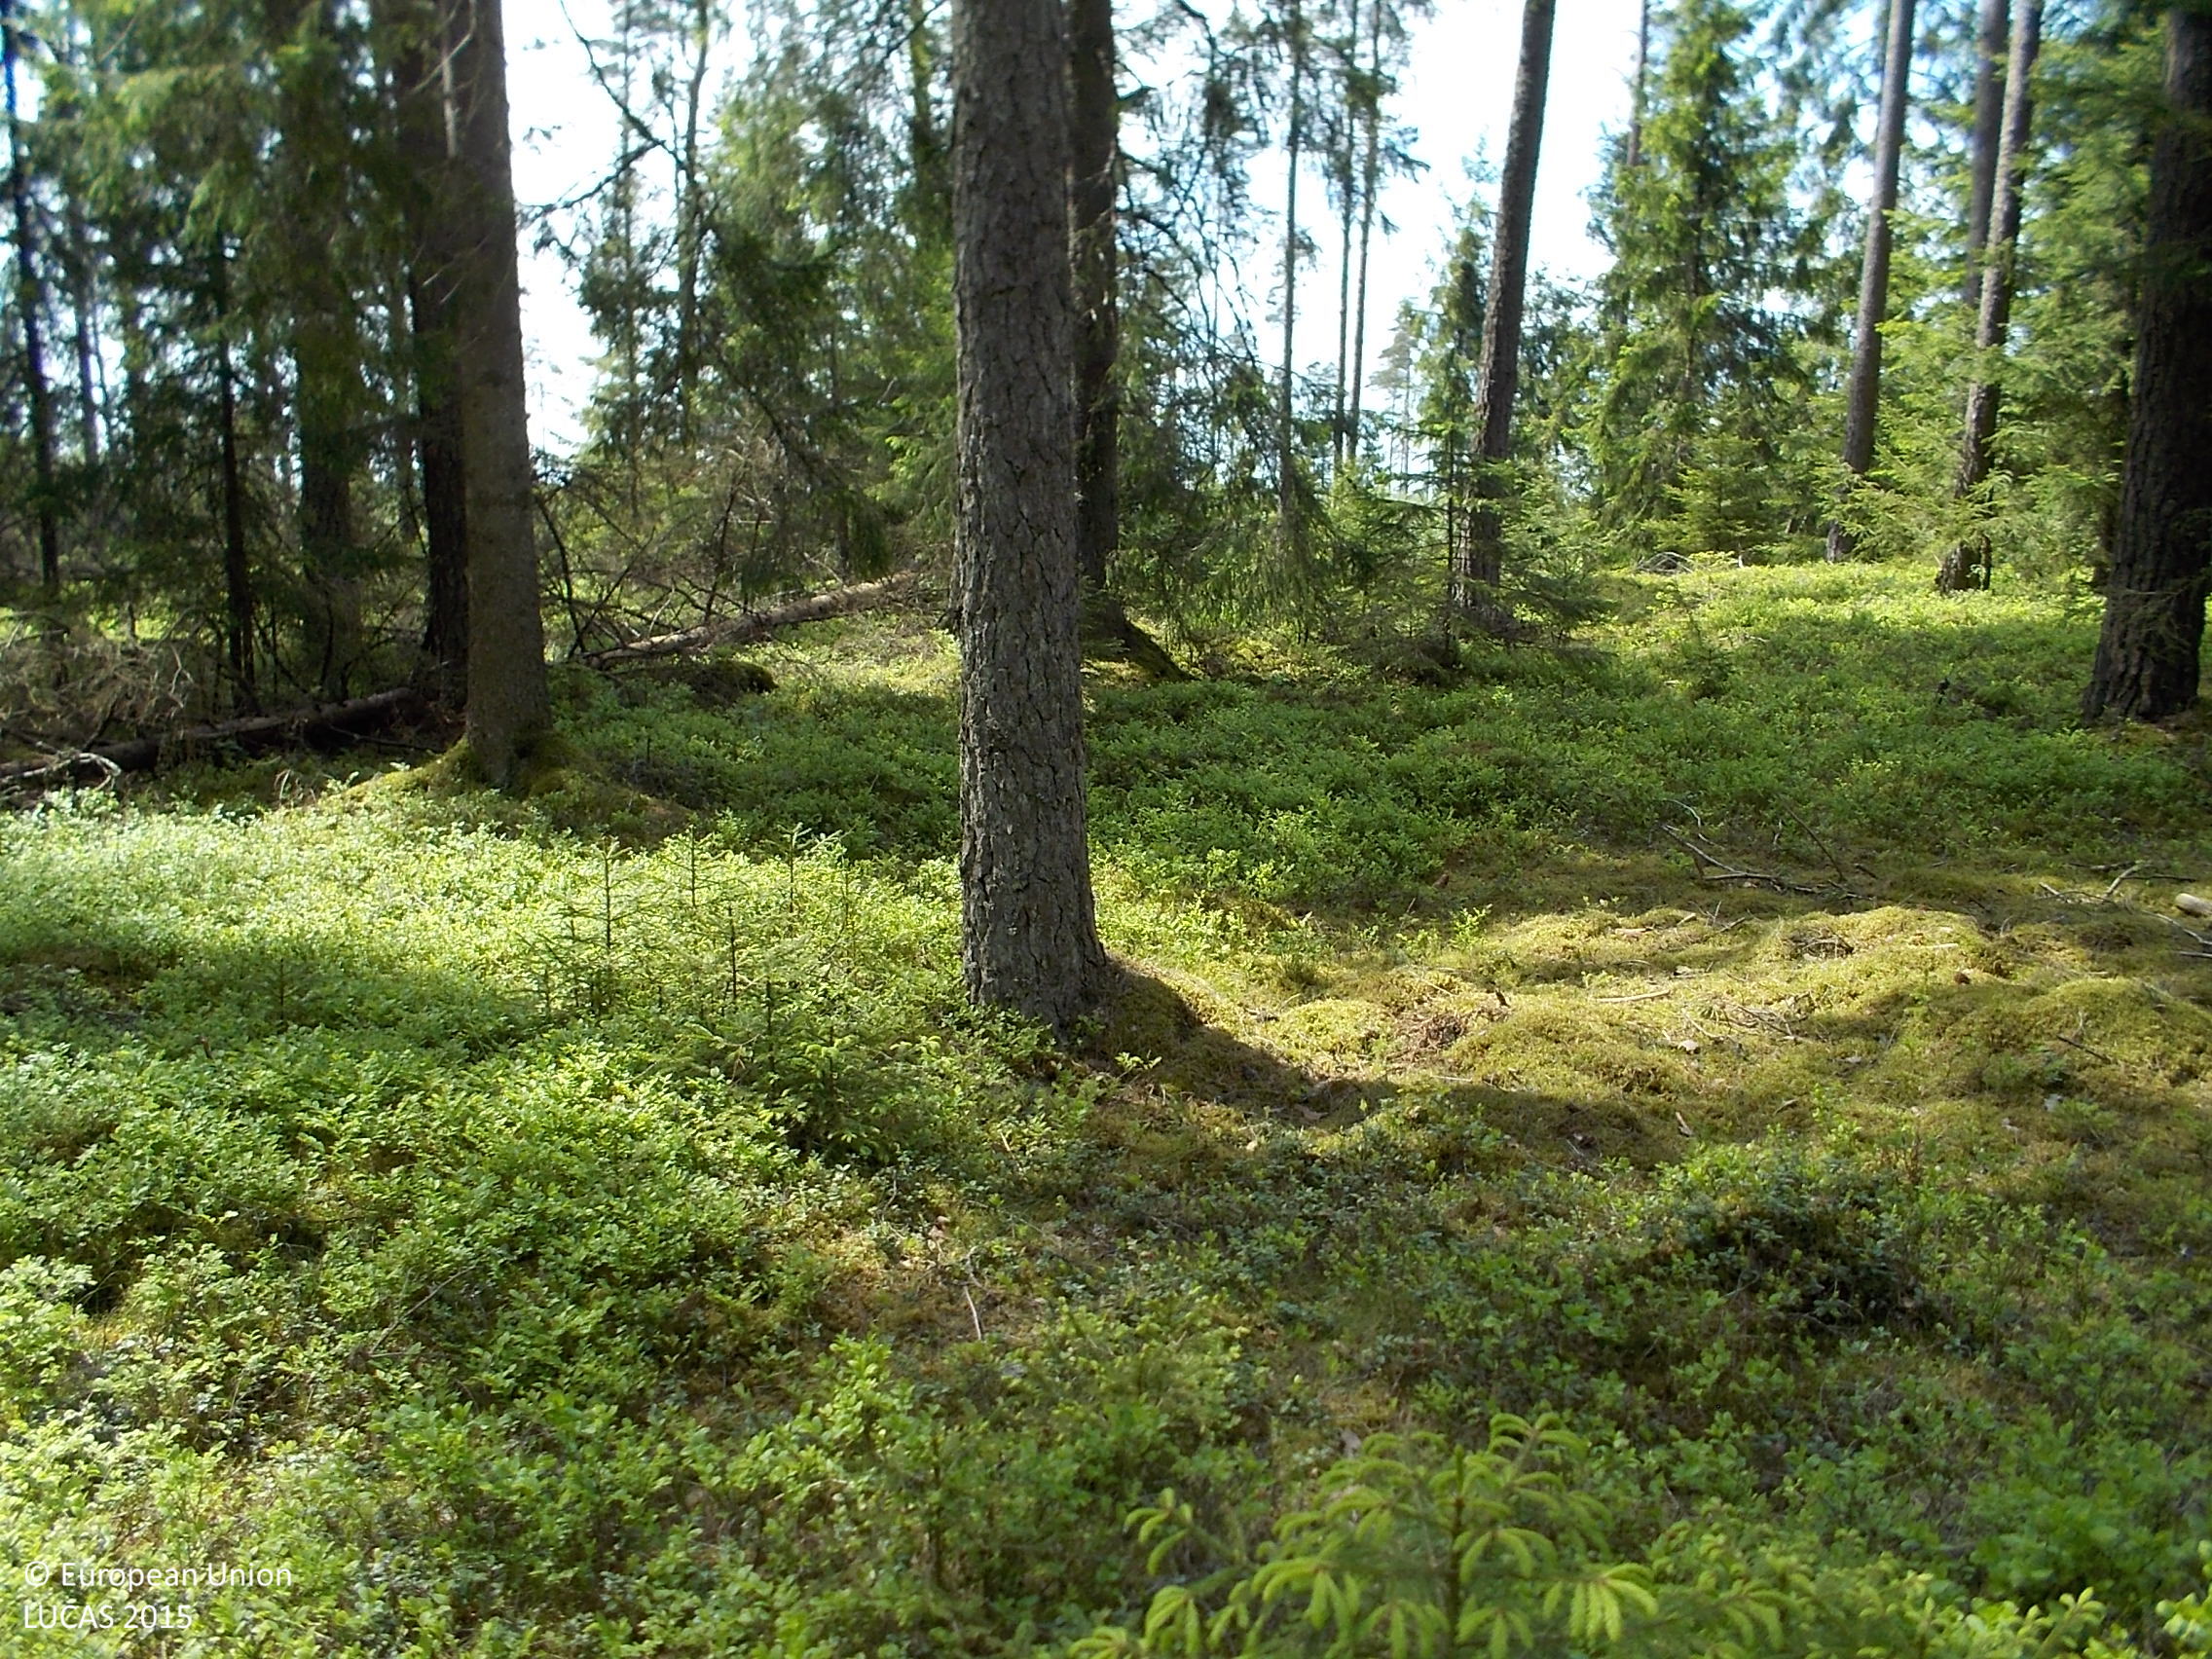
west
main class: Woodland
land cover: Spruce dominated coniferous woodland
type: boreal forest
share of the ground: 50 - 75 %
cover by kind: coniferous forest trees 70 %, shrubs 30 %
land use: Forestry
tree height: > 5 m
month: June
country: SE
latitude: 57.4838
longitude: 13.0149
